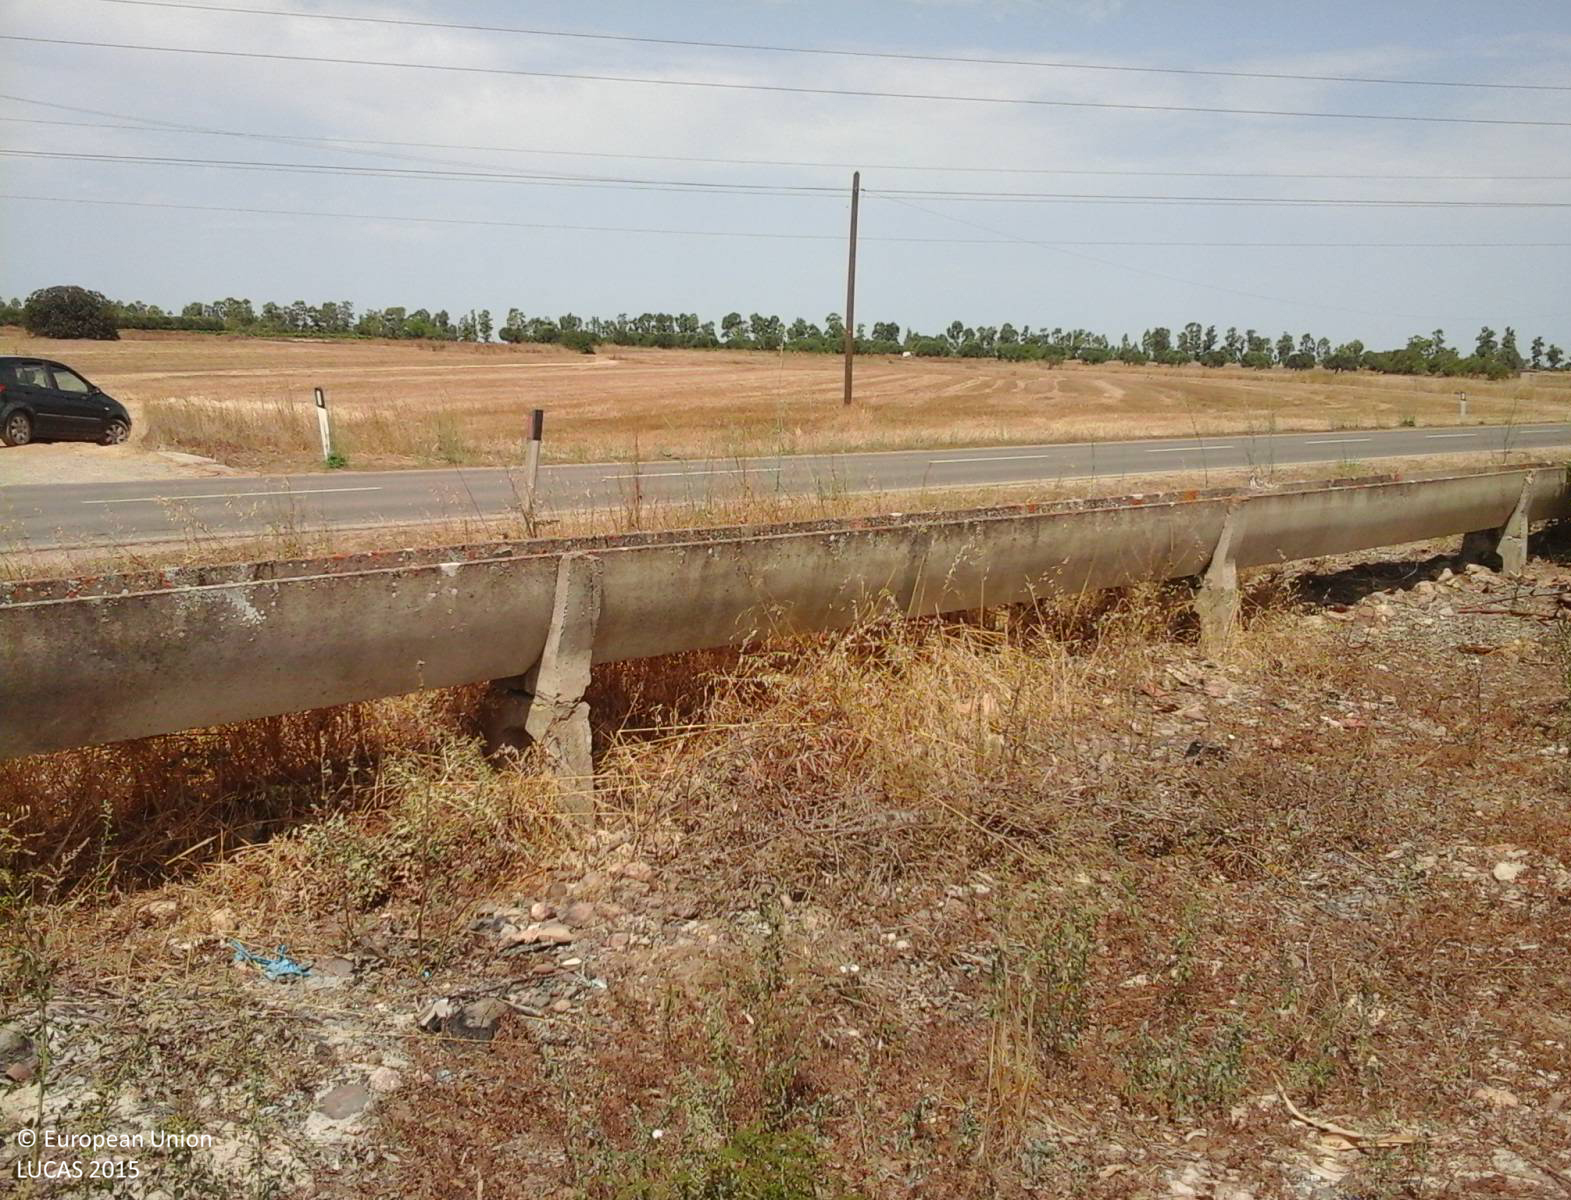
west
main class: Cropland
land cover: Olive groves
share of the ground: > 75 %
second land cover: Grassland without tree/shrub cover
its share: > 75 %
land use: Agriculture (excluding fallow land and kitchen gardens)
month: July
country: IT
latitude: 39.5005
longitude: 8.9018
